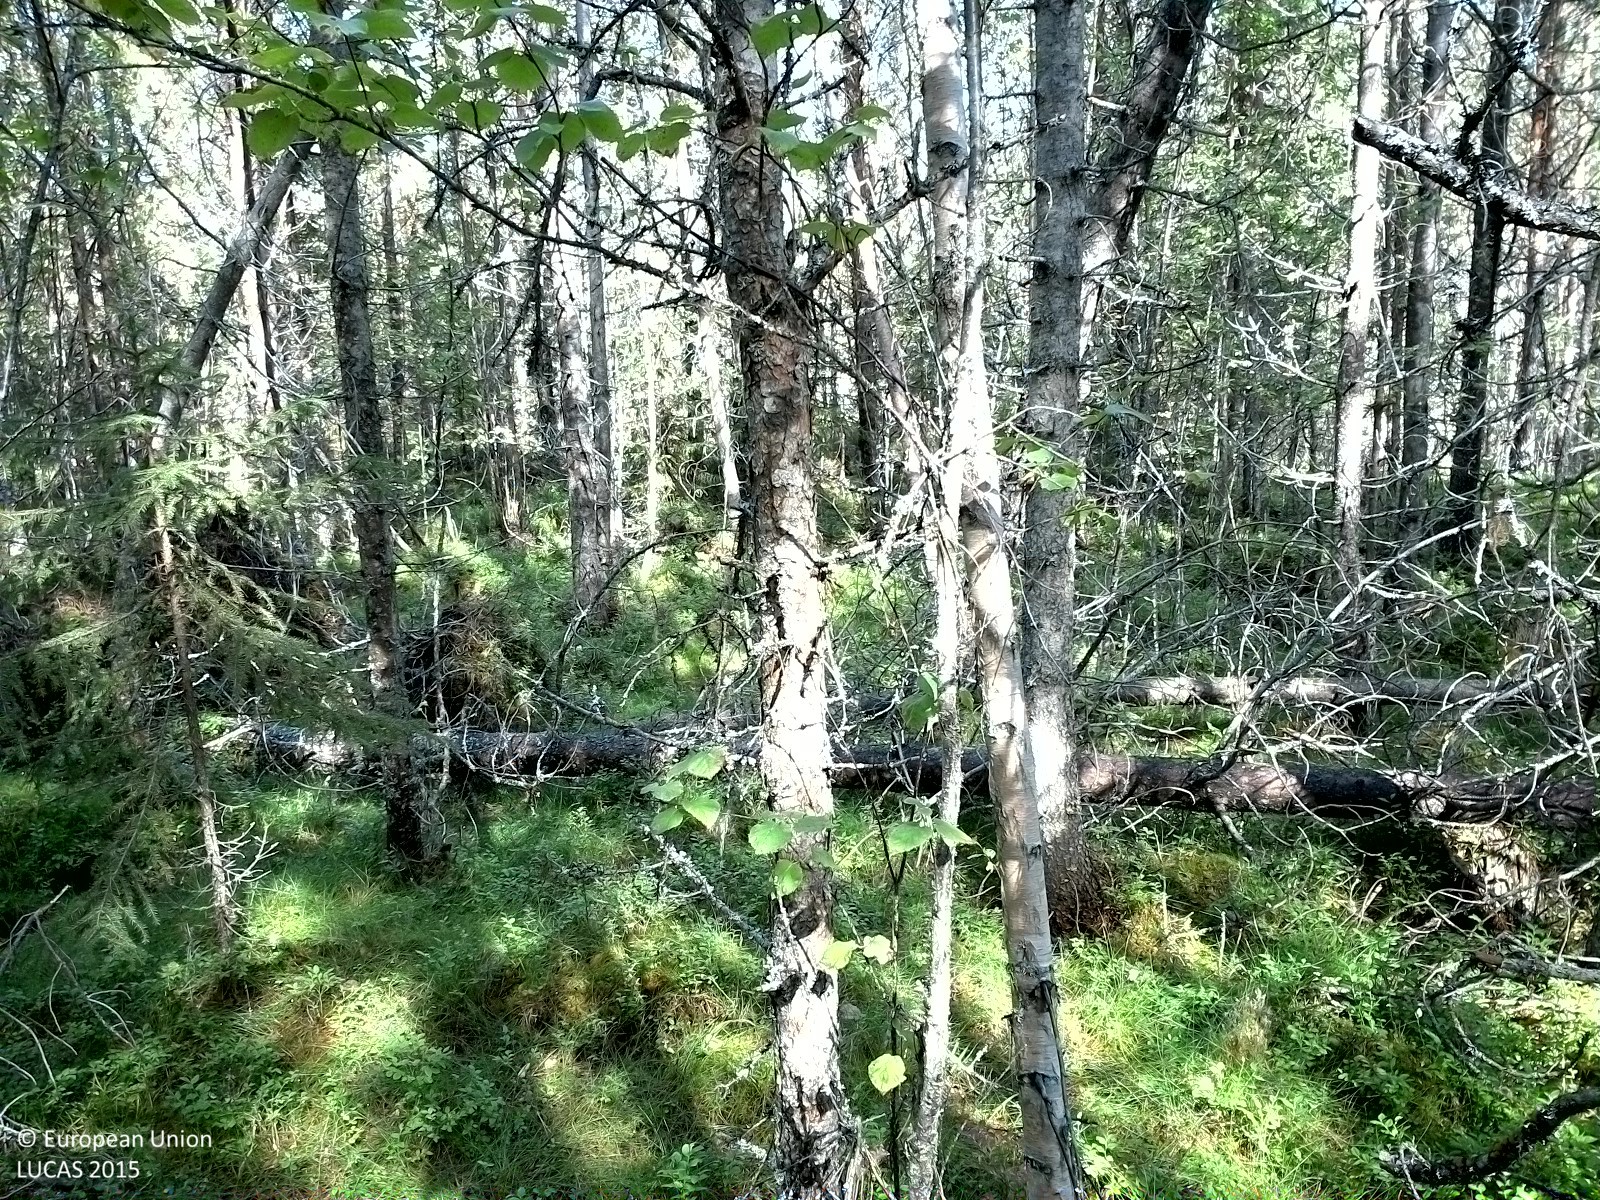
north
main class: Woodland
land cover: Pine dominated coniferous woodland
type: exotic forest
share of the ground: 50 - 75 %
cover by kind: coniferous forest trees 70 %, shrubs 10 %, herbaceous plants 10 %, lichens and mosses 10 %
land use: Forestry
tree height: > 5 m
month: September
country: SE
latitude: 62.5676
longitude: 16.3801
